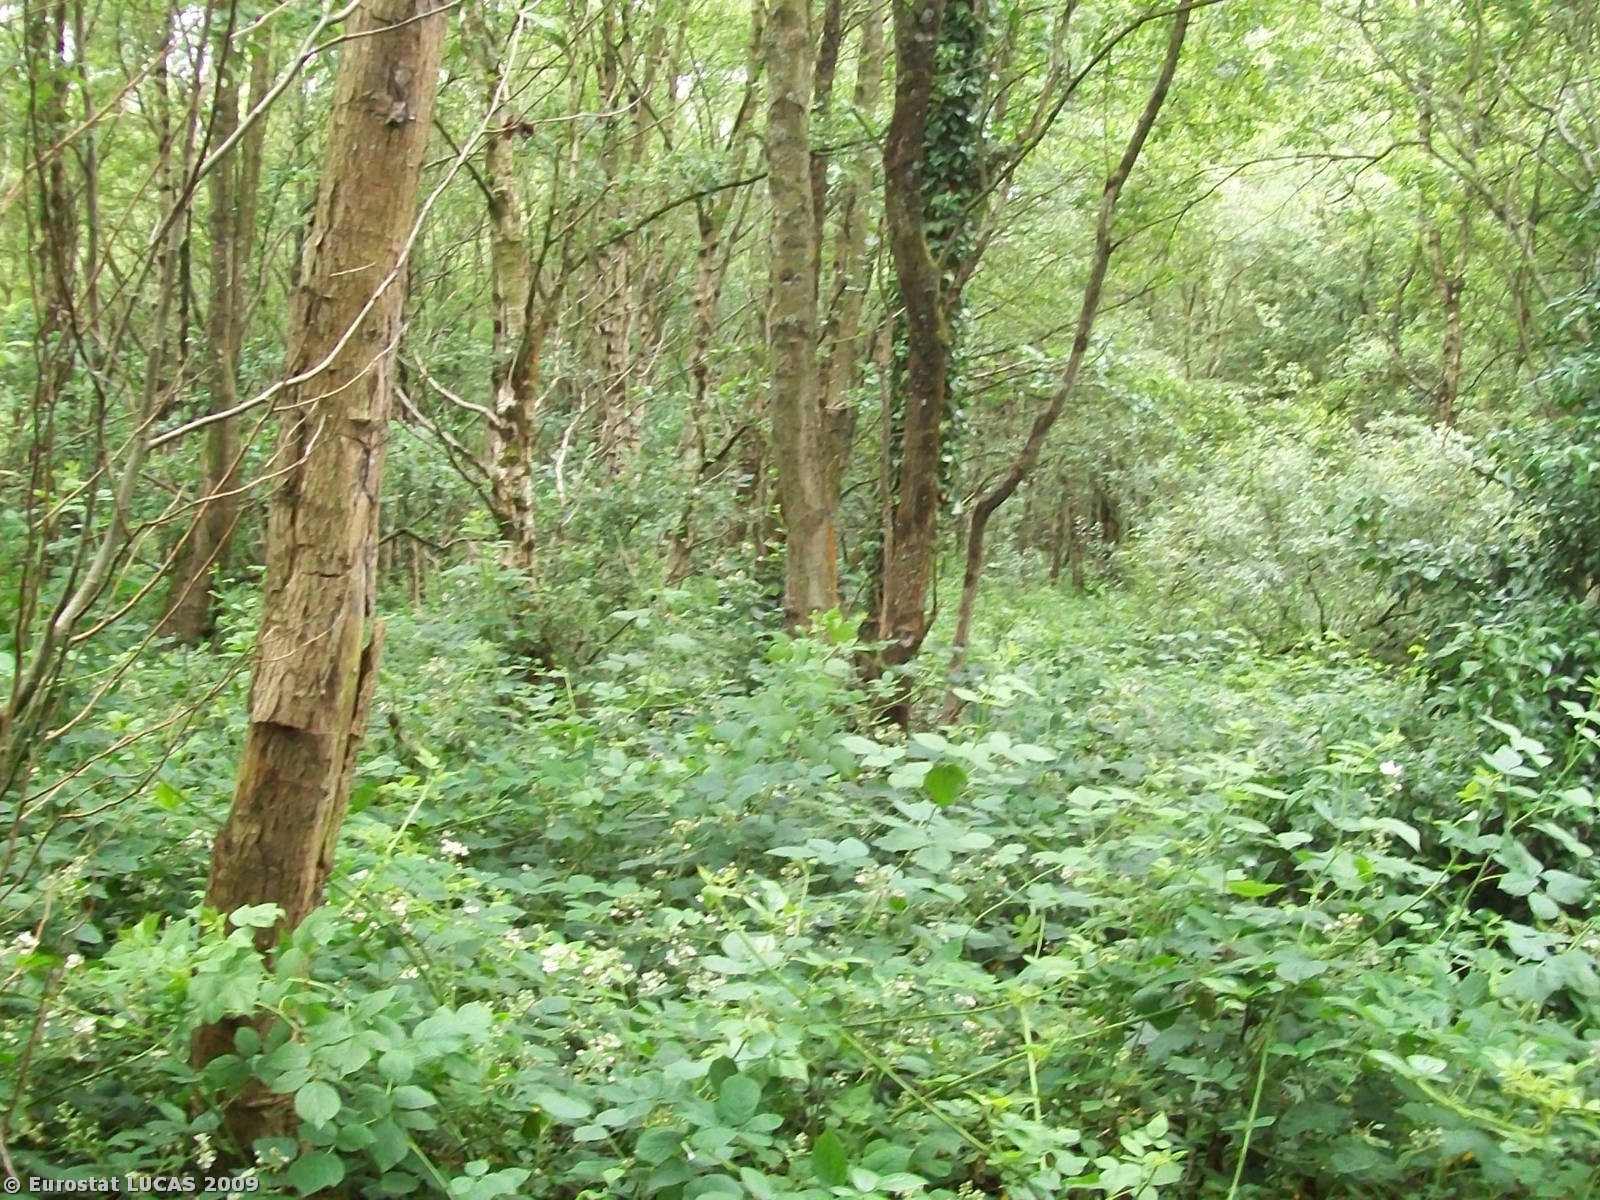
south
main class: Woodland
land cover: Broadleaved woodland
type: mesophytic deciduous forest
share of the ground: > 75 %
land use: Forestry
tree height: > 5 m
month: July
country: GB
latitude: 54.7840
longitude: -6.7213
